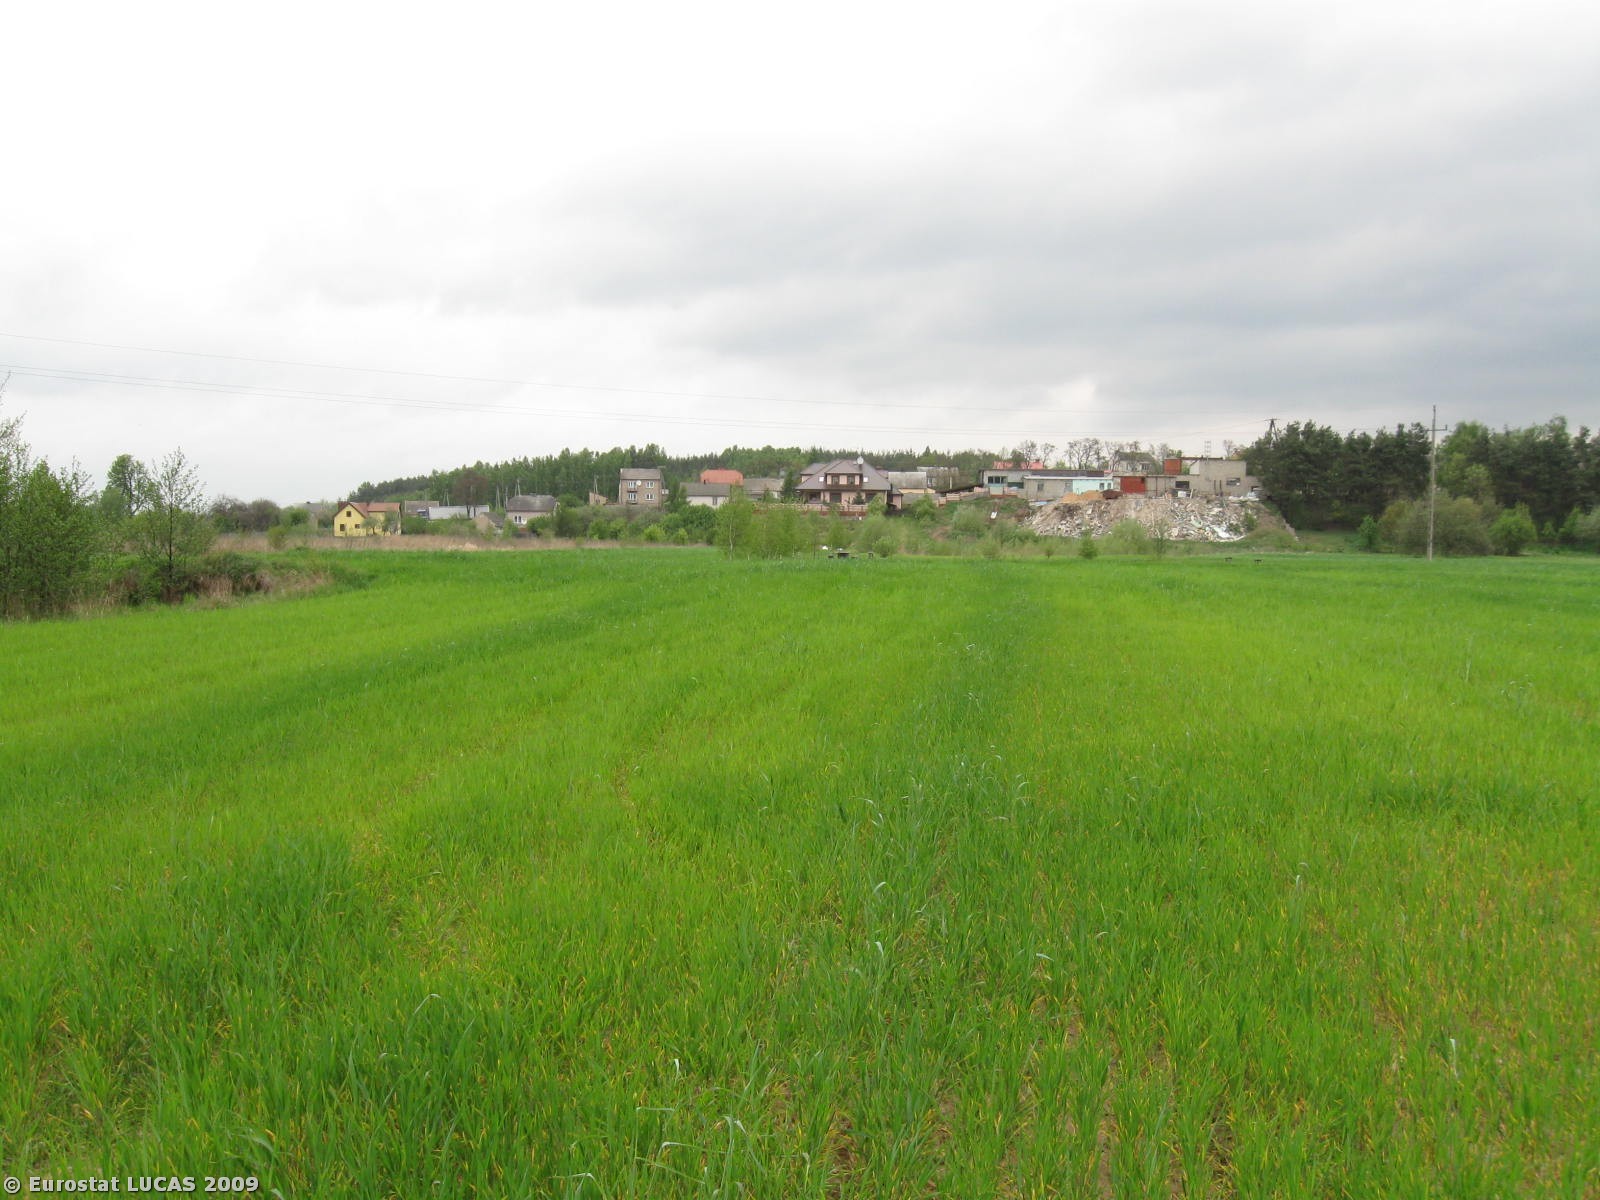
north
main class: Cropland
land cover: Rye
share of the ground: > 75 %
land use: Agriculture (excluding fallow land and kitchen gardens)
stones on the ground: < 10 %
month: May
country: PL
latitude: 50.9455
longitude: 21.3067
